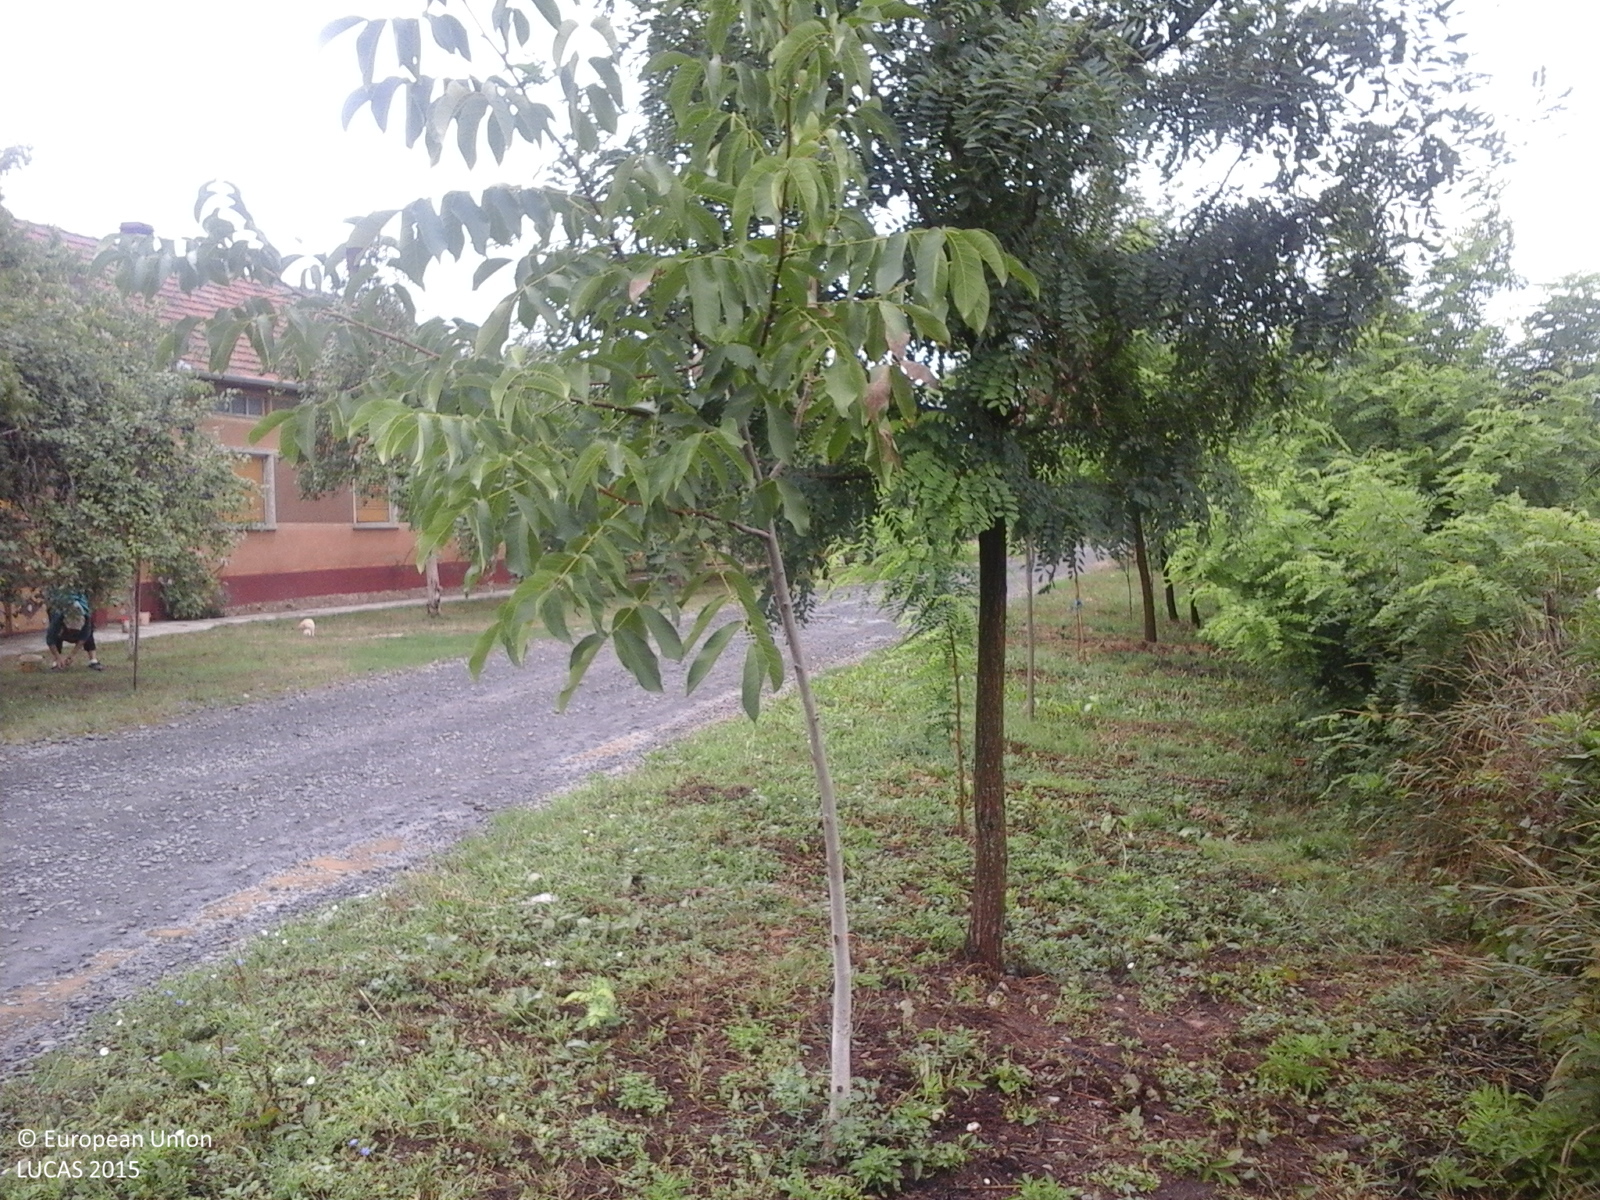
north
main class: Cropland
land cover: Lucerne
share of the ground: > 75 %
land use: Agriculture (excluding fallow land and kitchen gardens)
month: August
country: RO
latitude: 45.7203
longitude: 21.7409
